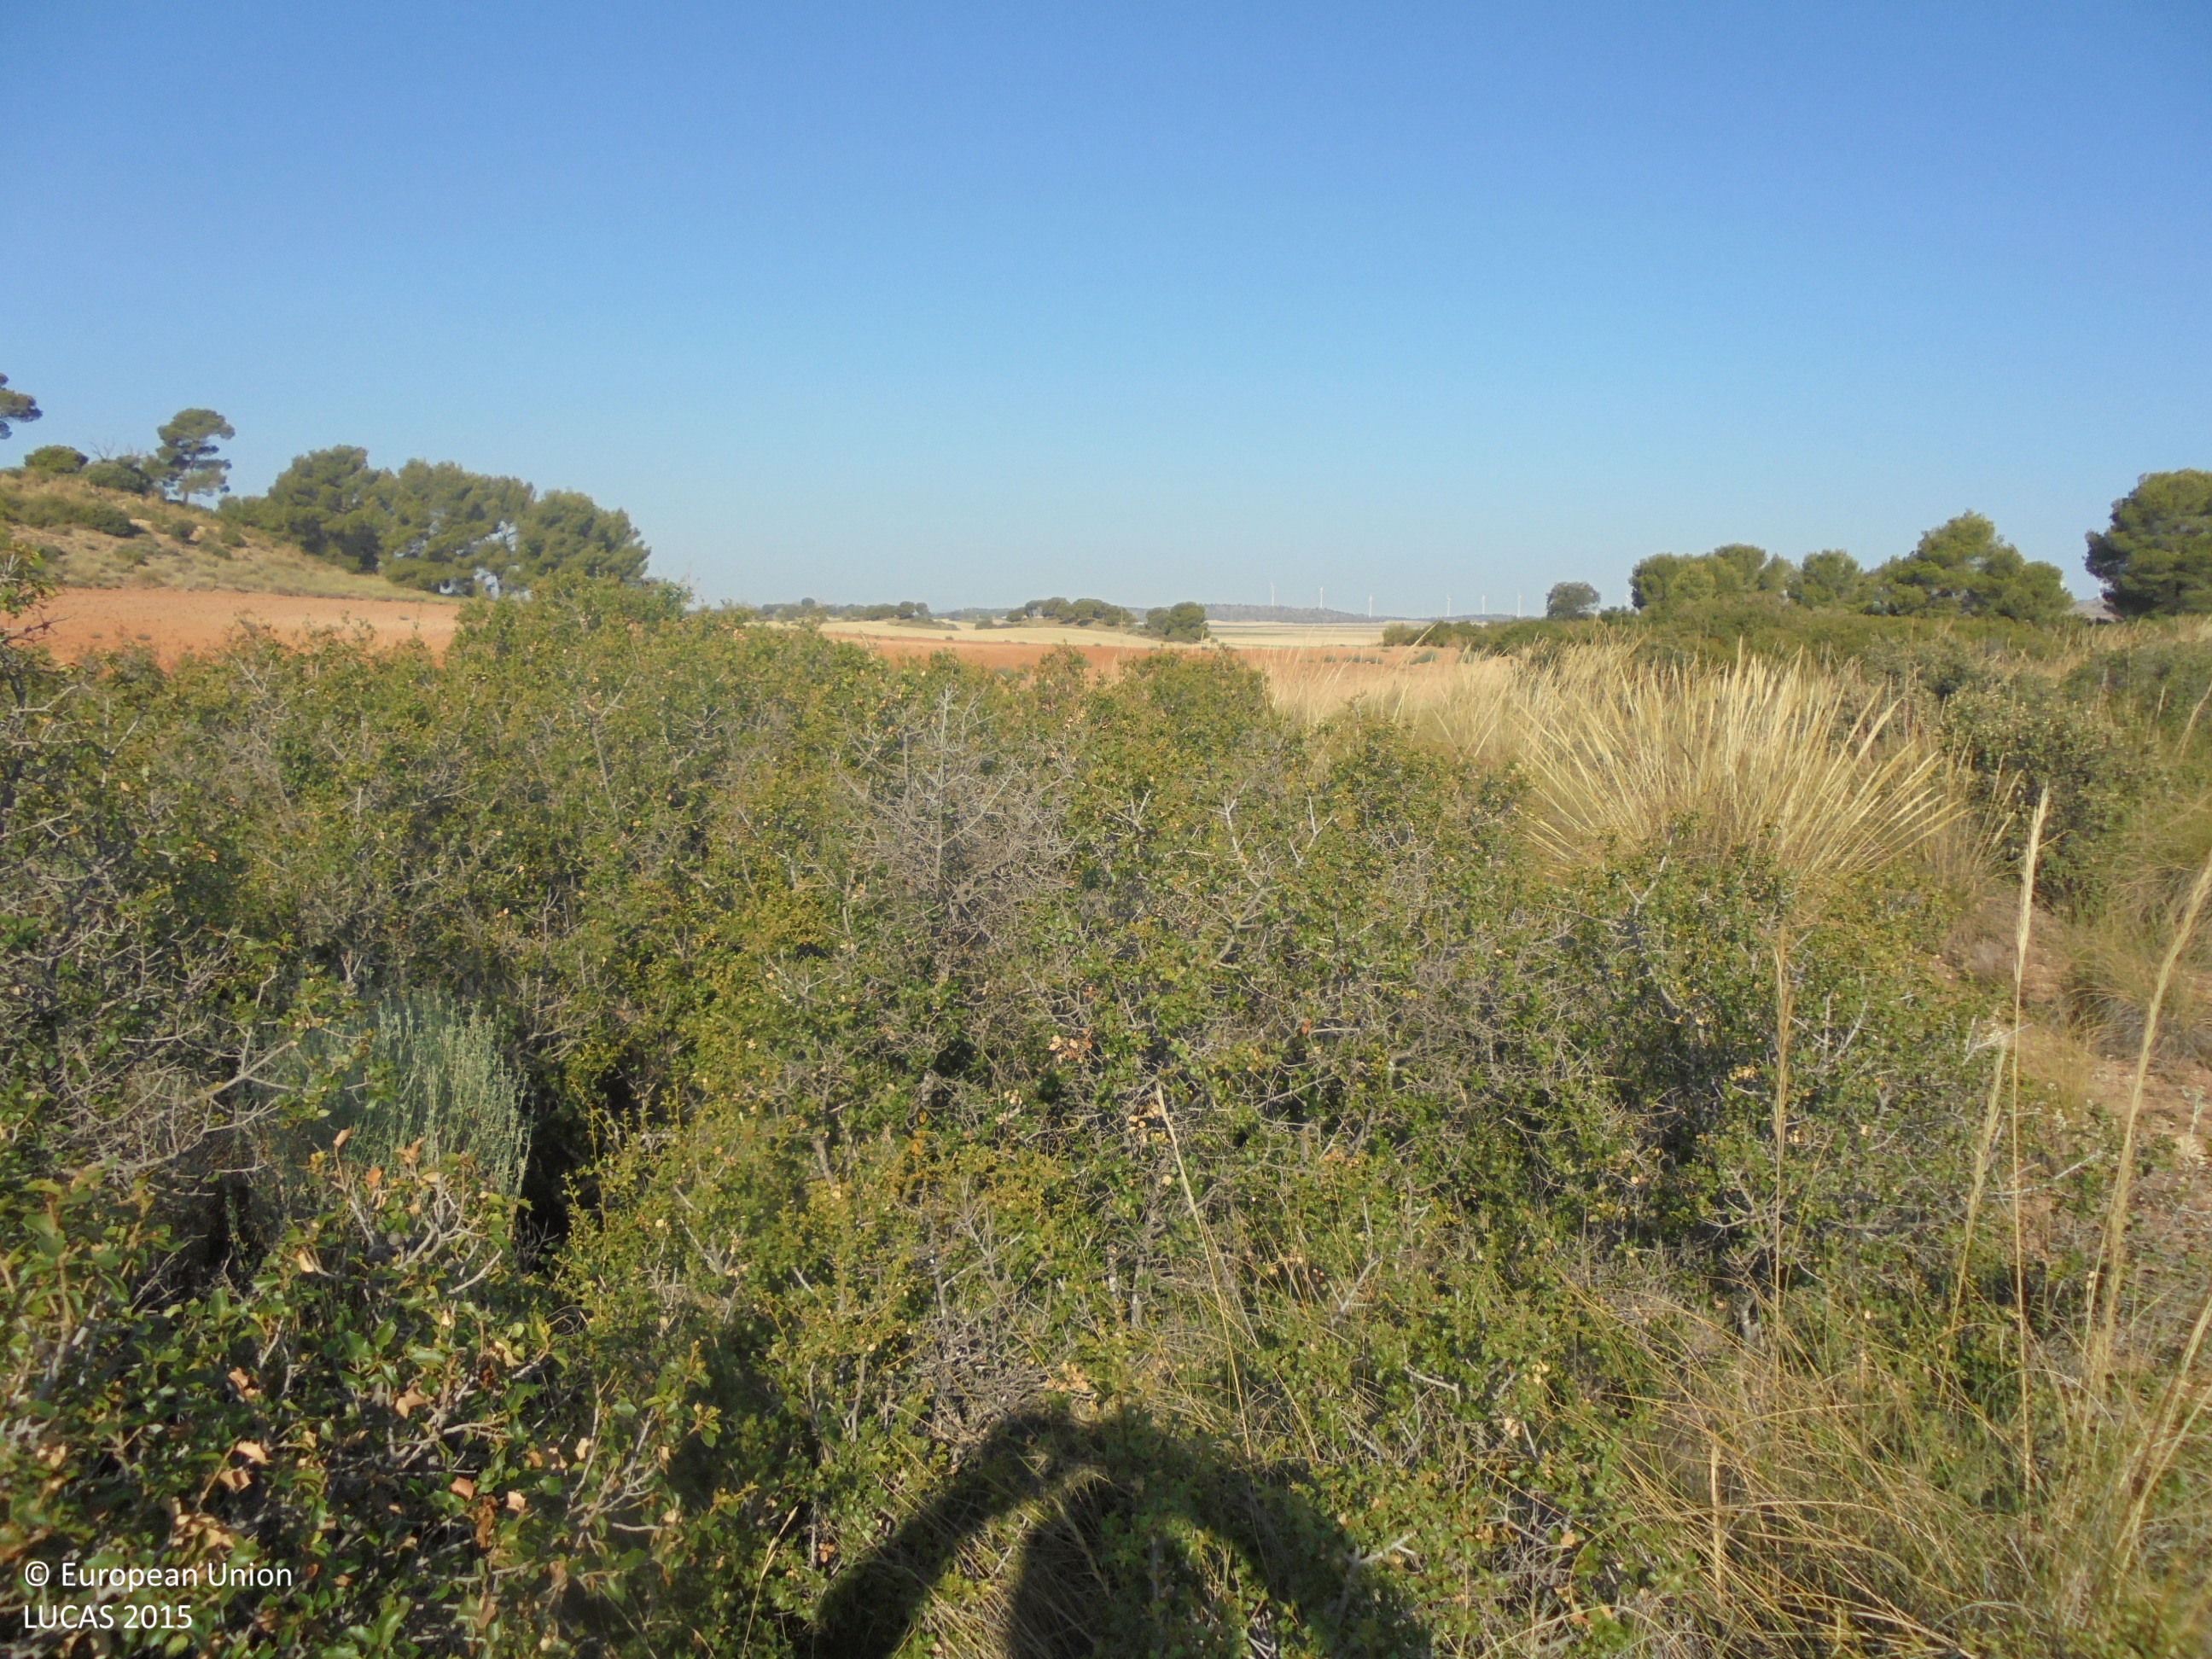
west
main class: Shrubland
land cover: Shrubland with sparse tree cover
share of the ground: > 75 %
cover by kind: shrubs 80 %, unconsolidated bare surface 15 %, coniferous forest trees 5 %
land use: Semi-natural and natural areas not in use
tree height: < 5 m
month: July
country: ES
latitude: 38.7056
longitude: -1.5515
